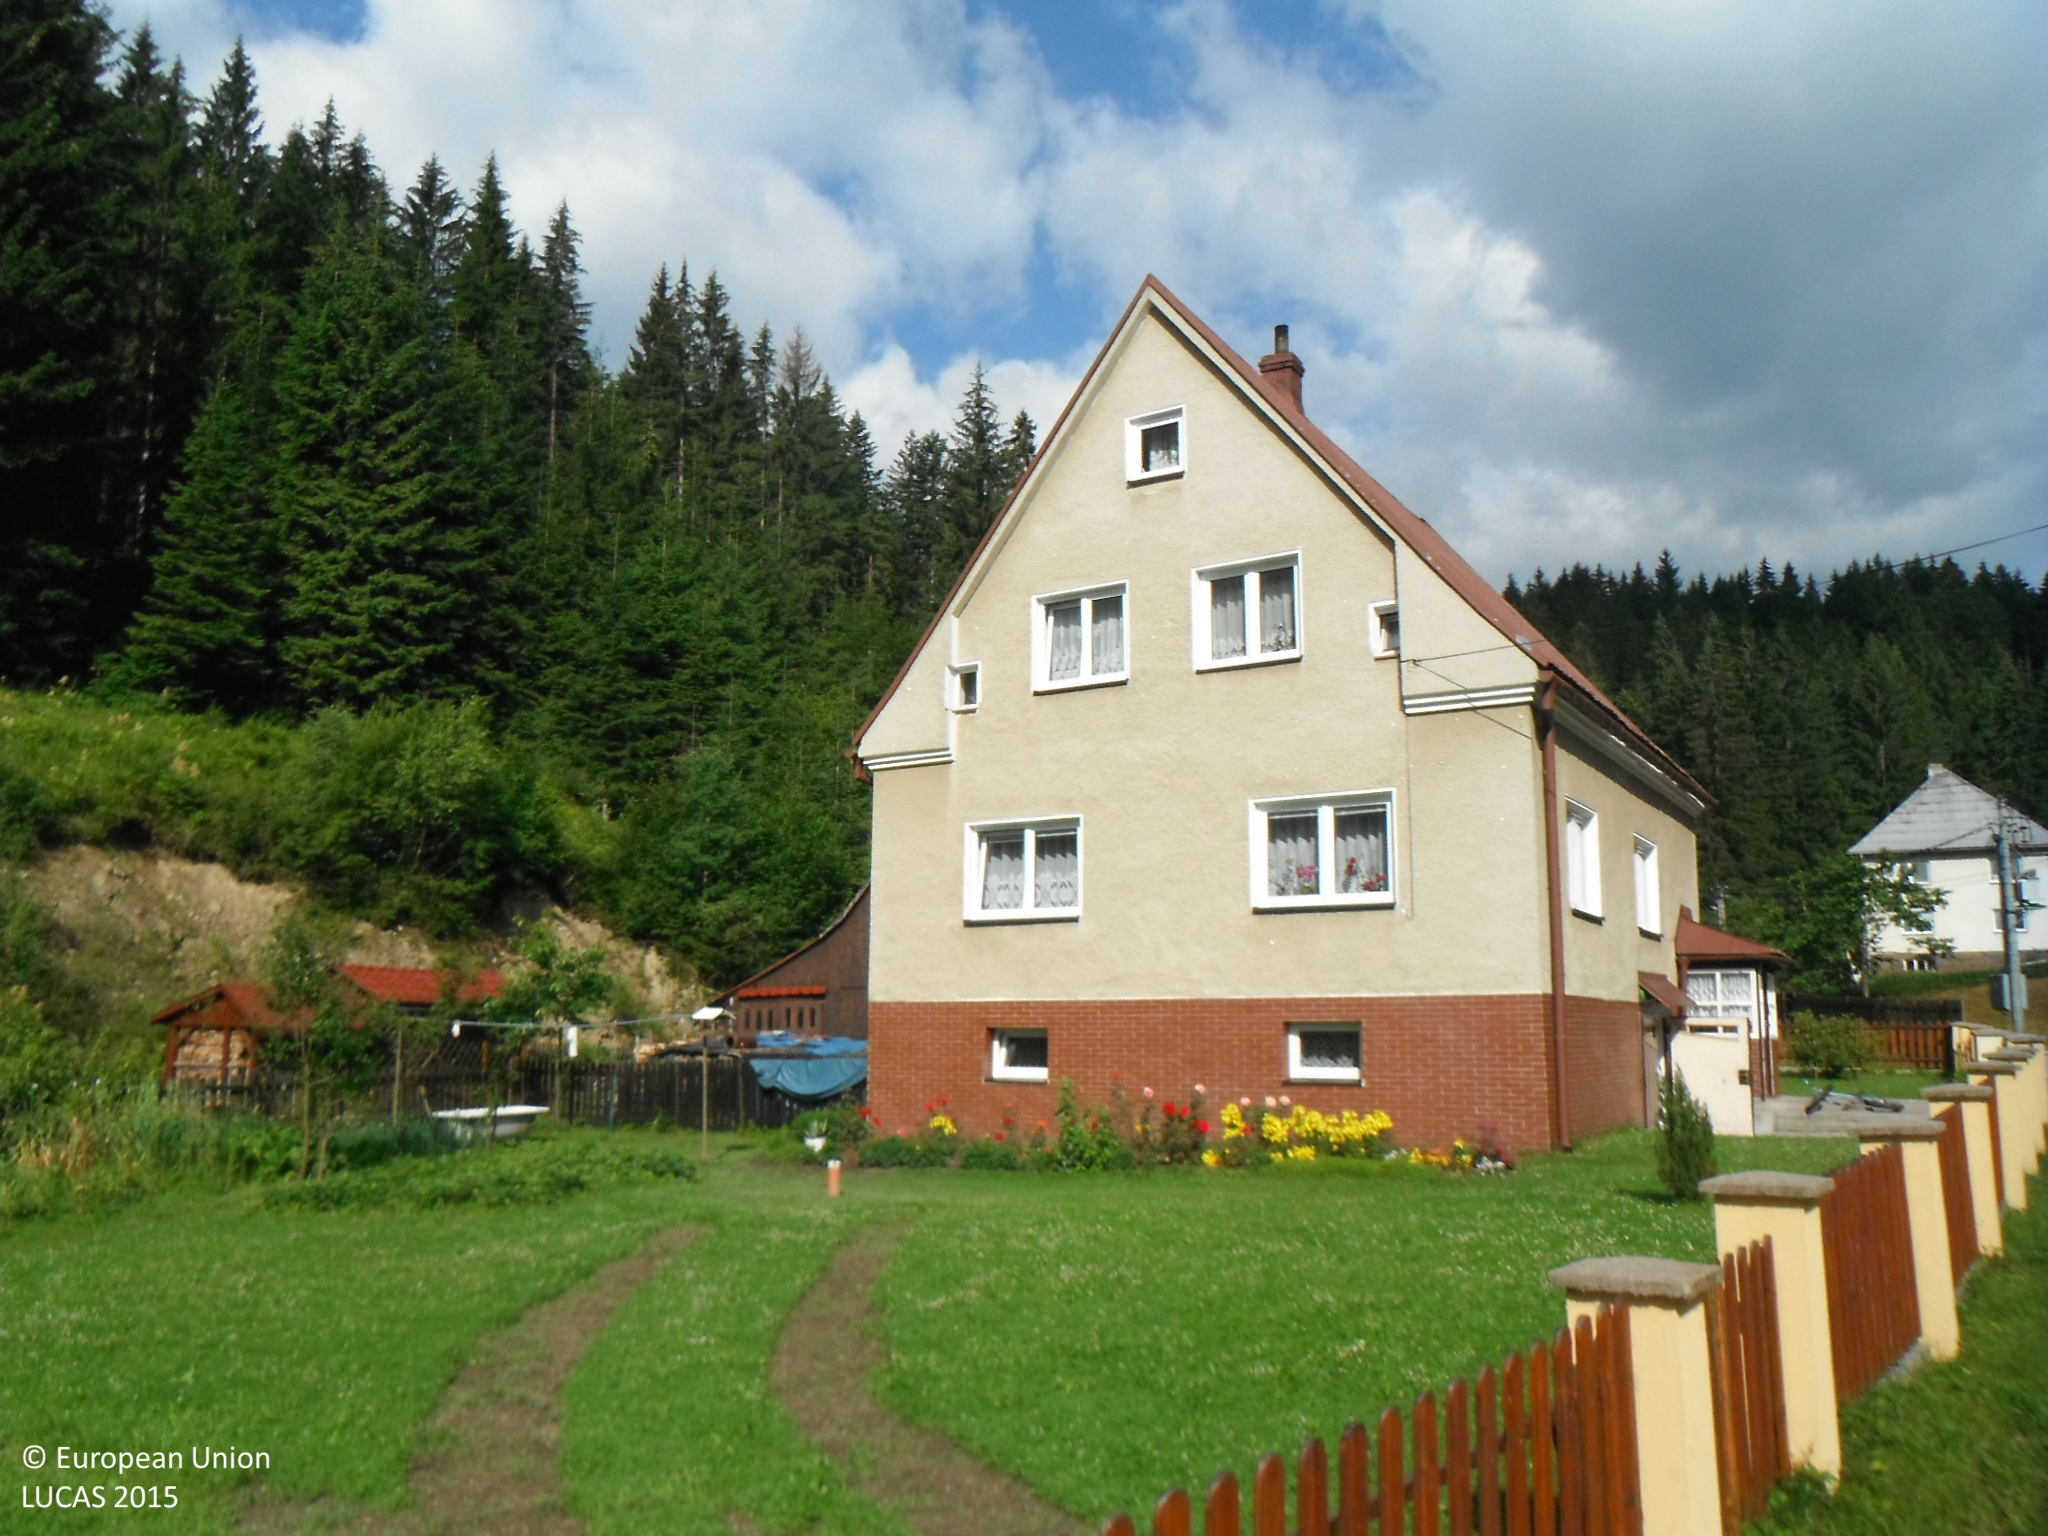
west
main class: Grassland
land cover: Grassland without tree/shrub cover
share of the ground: > 75 %
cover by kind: herbaceous plants 95 %
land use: Residential
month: July
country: SK
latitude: 49.4304
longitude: 18.5260
